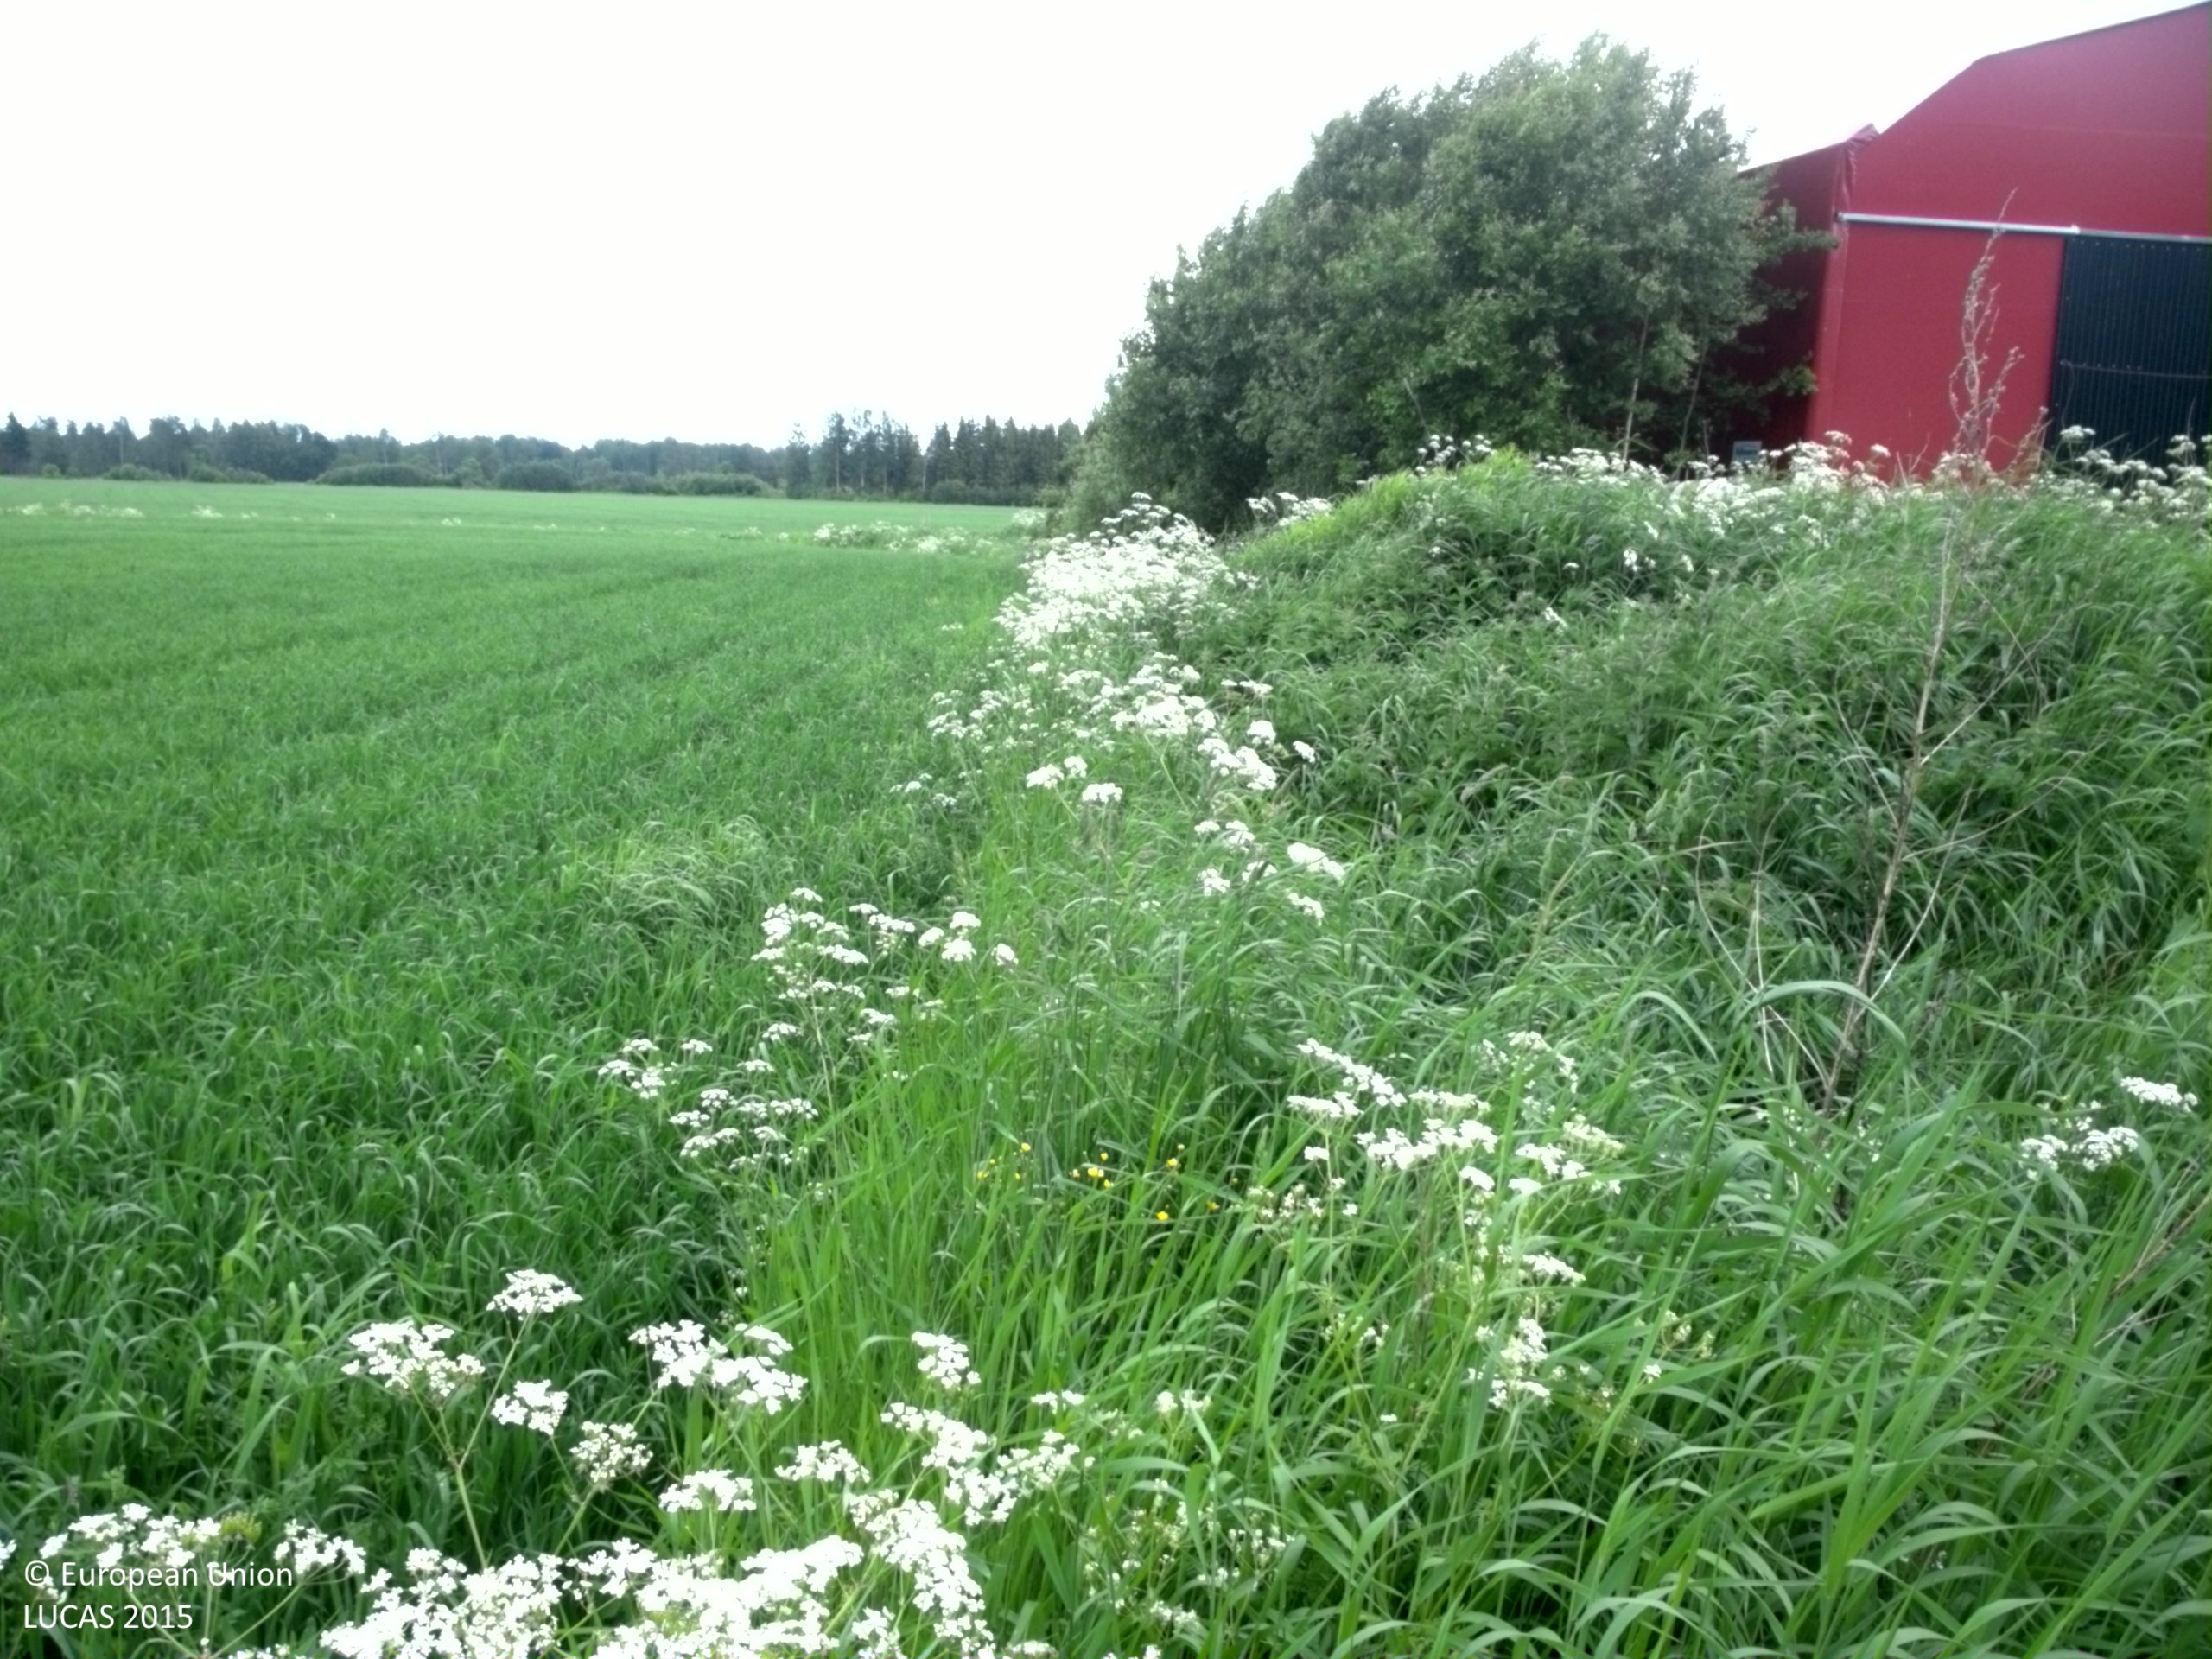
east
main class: Cropland
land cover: Common wheat
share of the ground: > 75 %
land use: Agriculture (excluding fallow land and kitchen gardens)
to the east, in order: Common wheat; Grass margins; Ditches and canals; Grass margins; Tracks; Oats
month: June
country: SE
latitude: 60.4279
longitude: 17.6028
